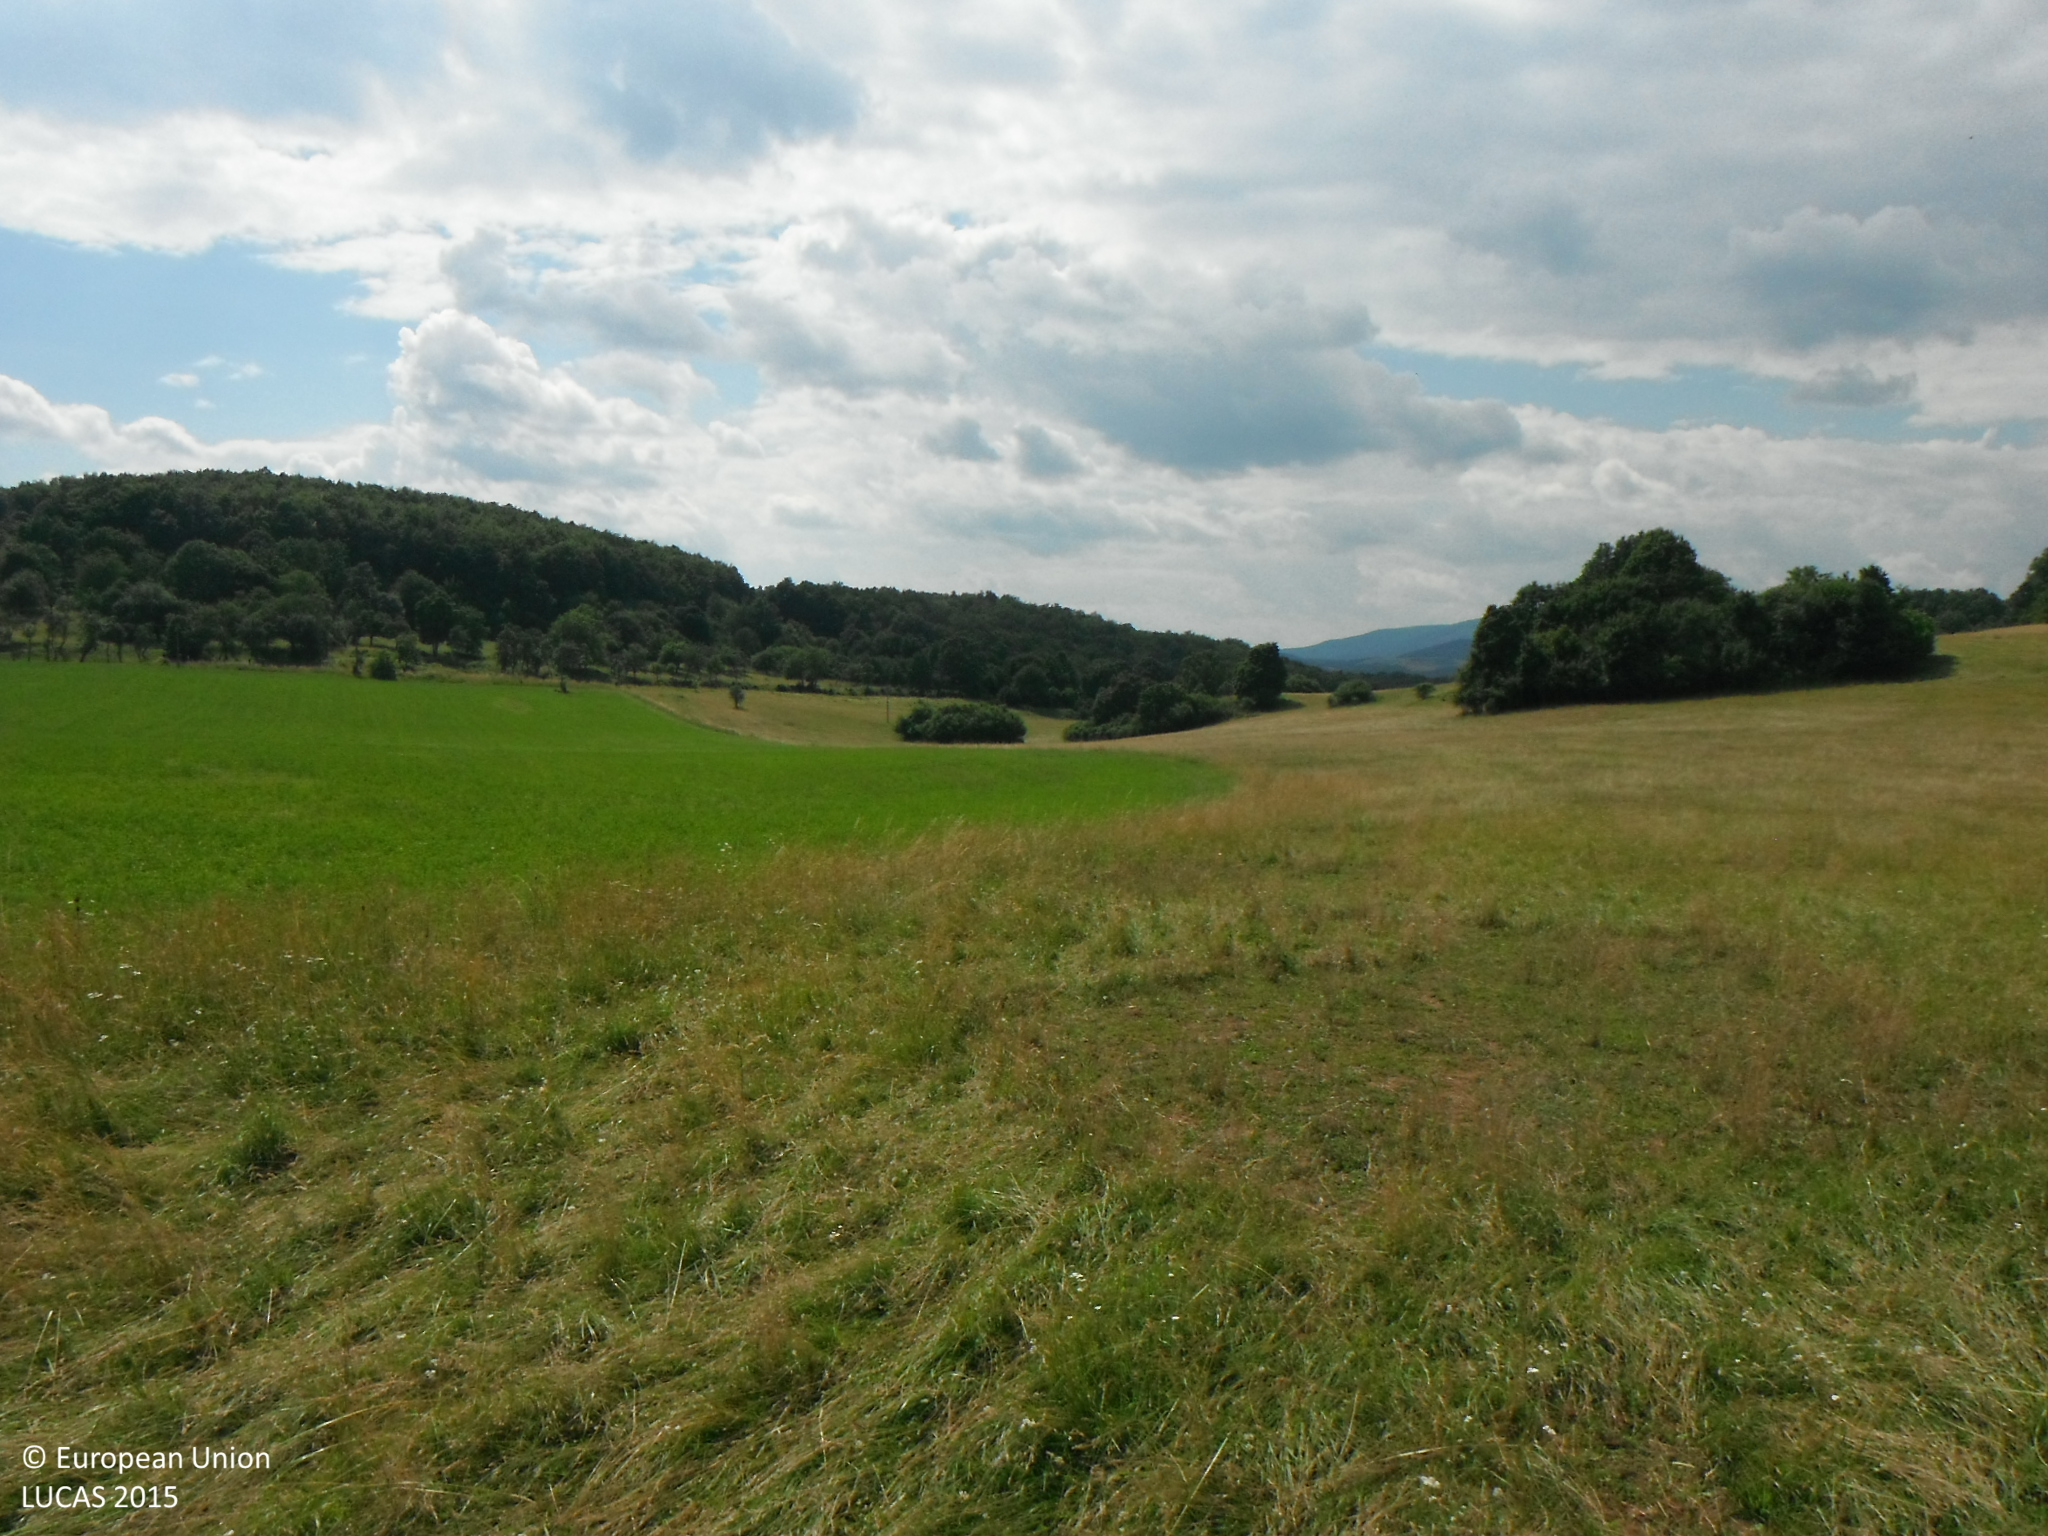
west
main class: Grassland
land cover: Grassland without tree/shrub cover
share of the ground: > 75 %
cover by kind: herbaceous plants 100 %
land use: Agriculture (excluding fallow land and kitchen gardens)
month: June
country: SK
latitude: 48.5210
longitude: 20.0902
